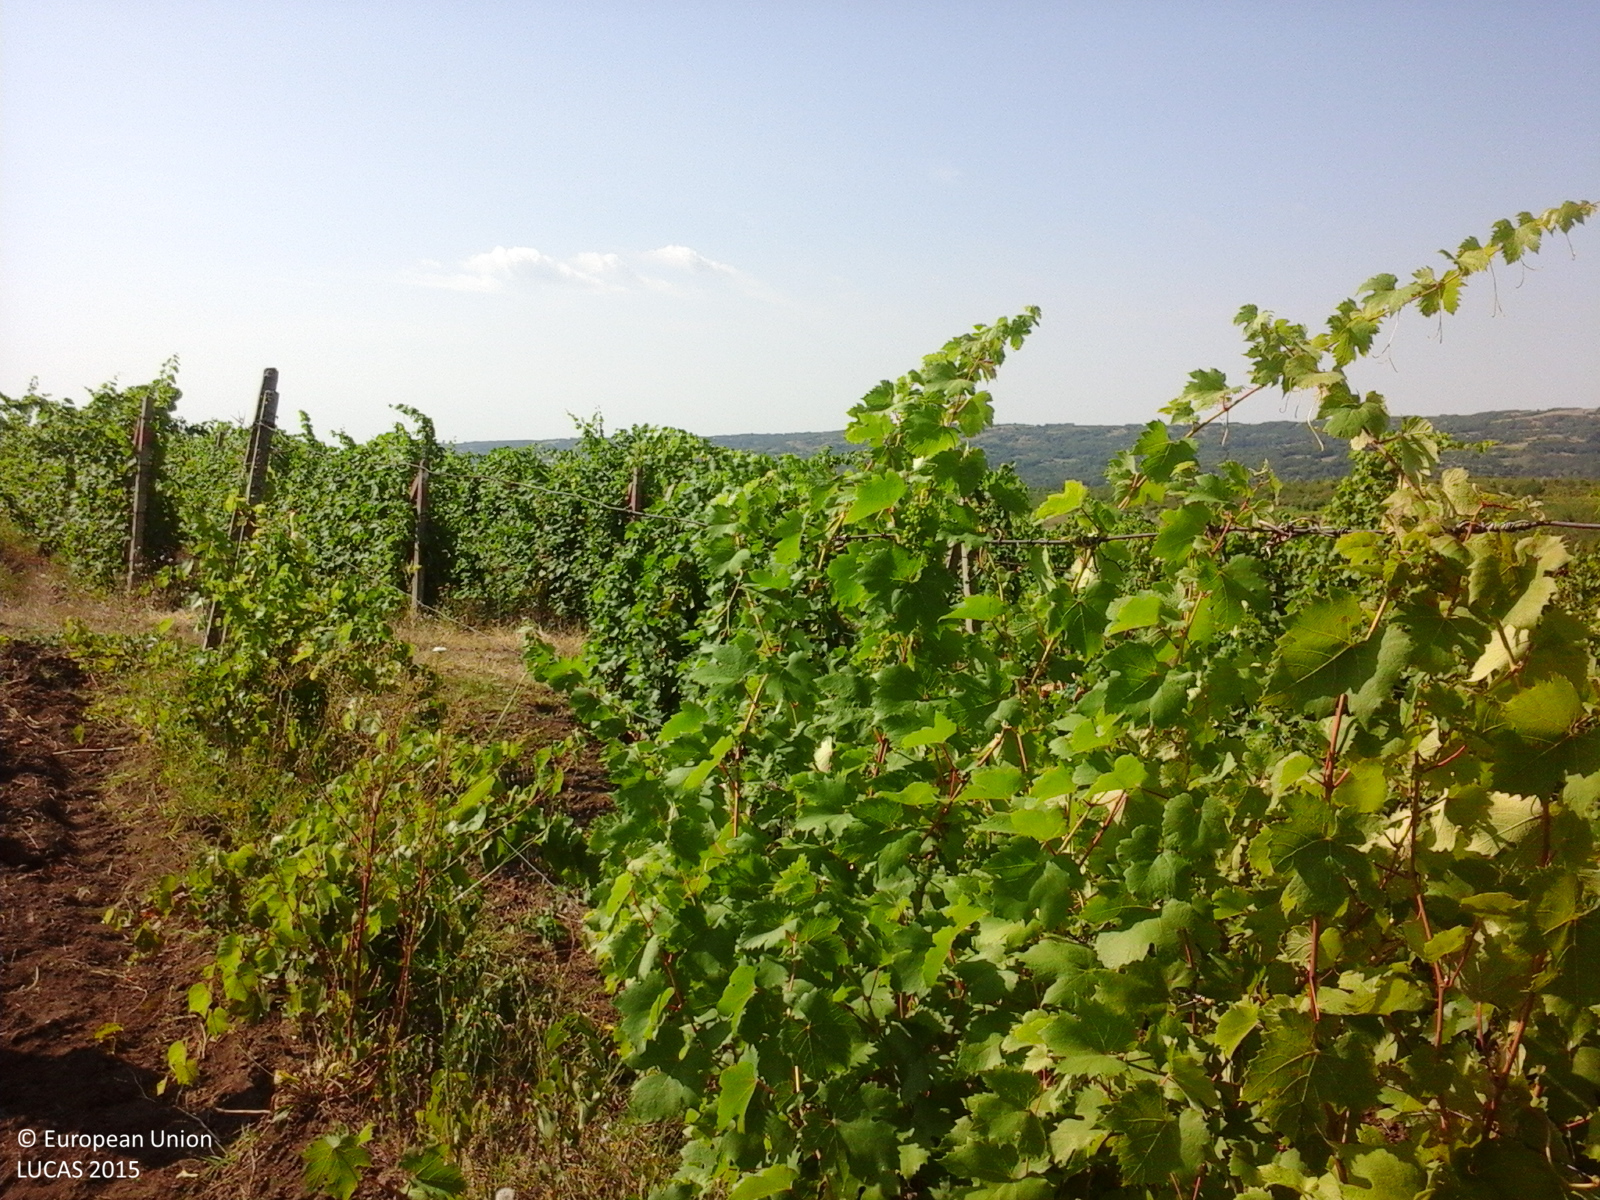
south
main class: Cropland
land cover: Vineyards
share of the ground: 50 - 75 %
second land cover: Other bare soil
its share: > 75 %
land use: Agriculture (excluding fallow land and kitchen gardens)
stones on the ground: < 10 %
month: July
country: RO
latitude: 46.0963
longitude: 28.0124
